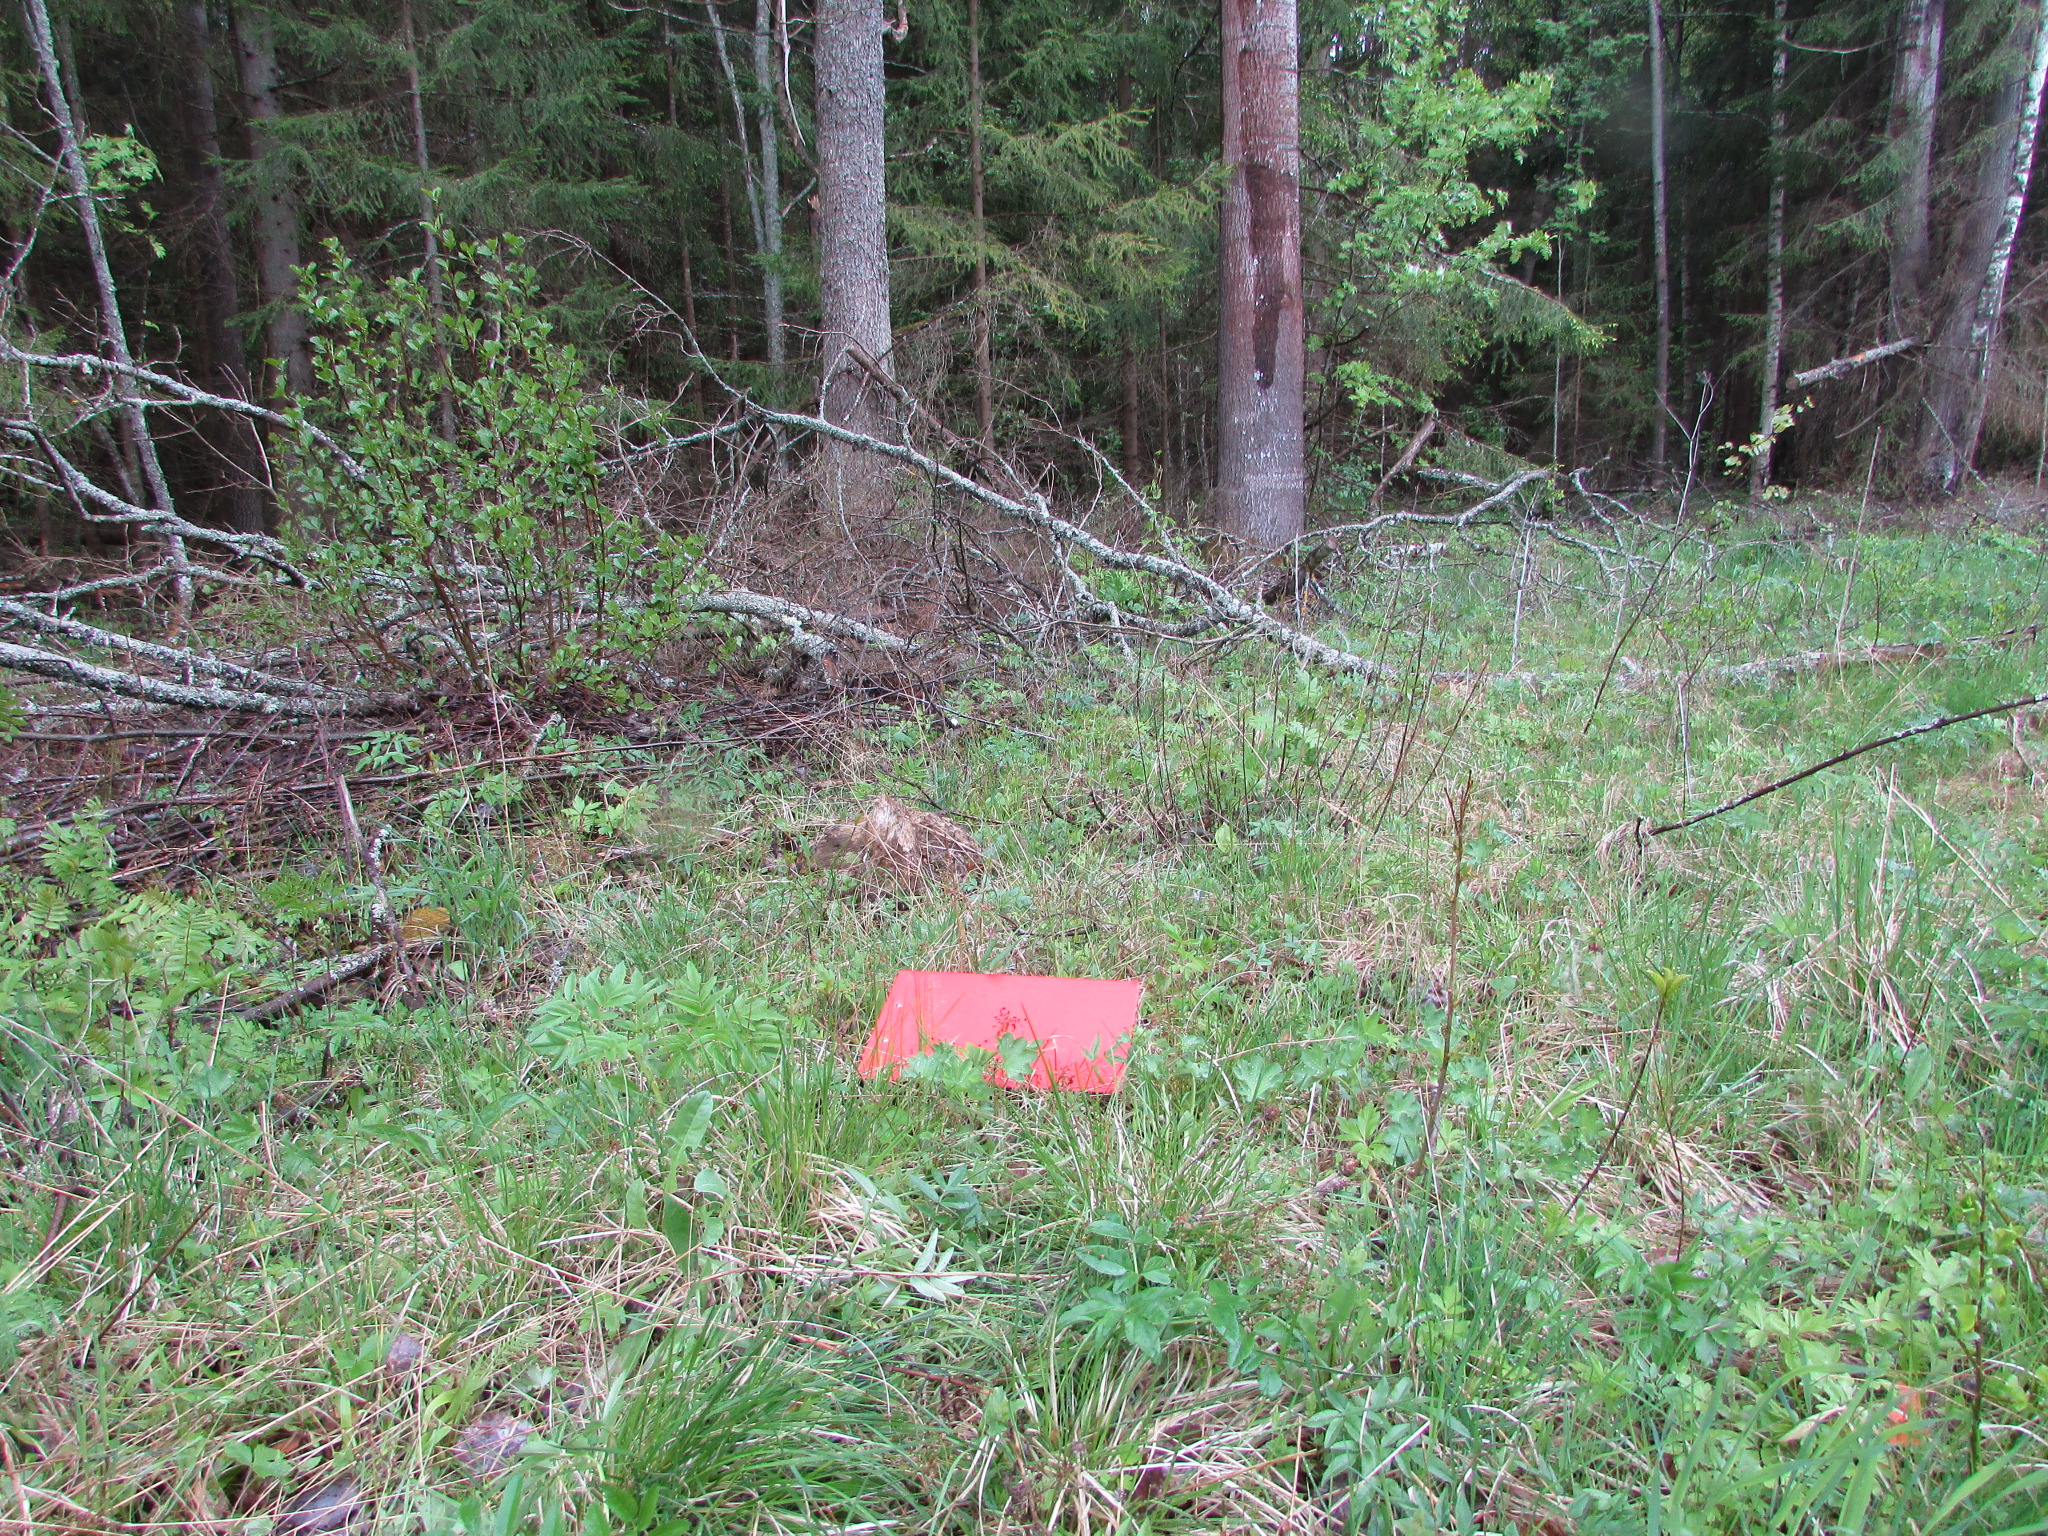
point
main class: Grassland
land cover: Grassland without tree/shrub cover
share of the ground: > 75 %
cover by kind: herbaceous plants 100 %
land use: Forestry
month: May
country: LV
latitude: 56.1101
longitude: 27.4001
